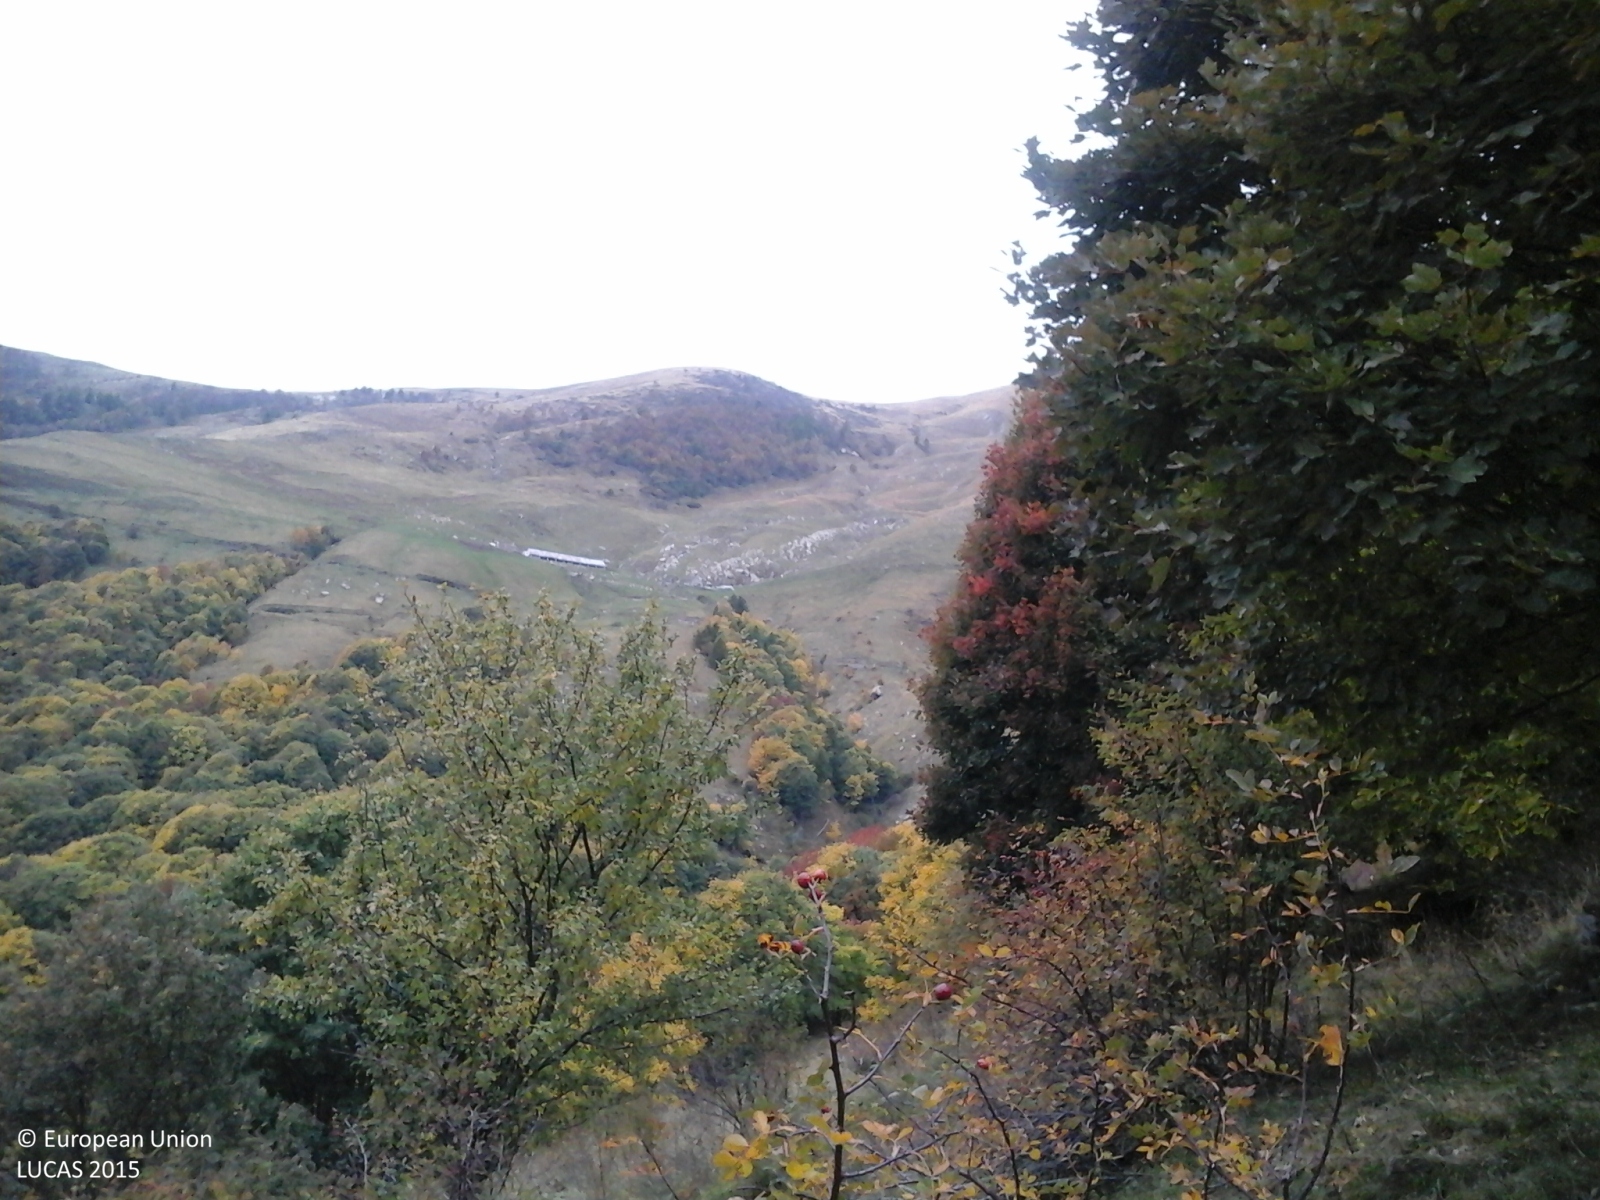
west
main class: Grassland
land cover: Grassland without tree/shrub cover
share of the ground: > 75 %
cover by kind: herbaceous plants 90 %, consolidated bare surface 10 %
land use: Agriculture (excluding fallow land and kitchen gardens)
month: October
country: IT
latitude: 44.0560
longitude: 7.7708
